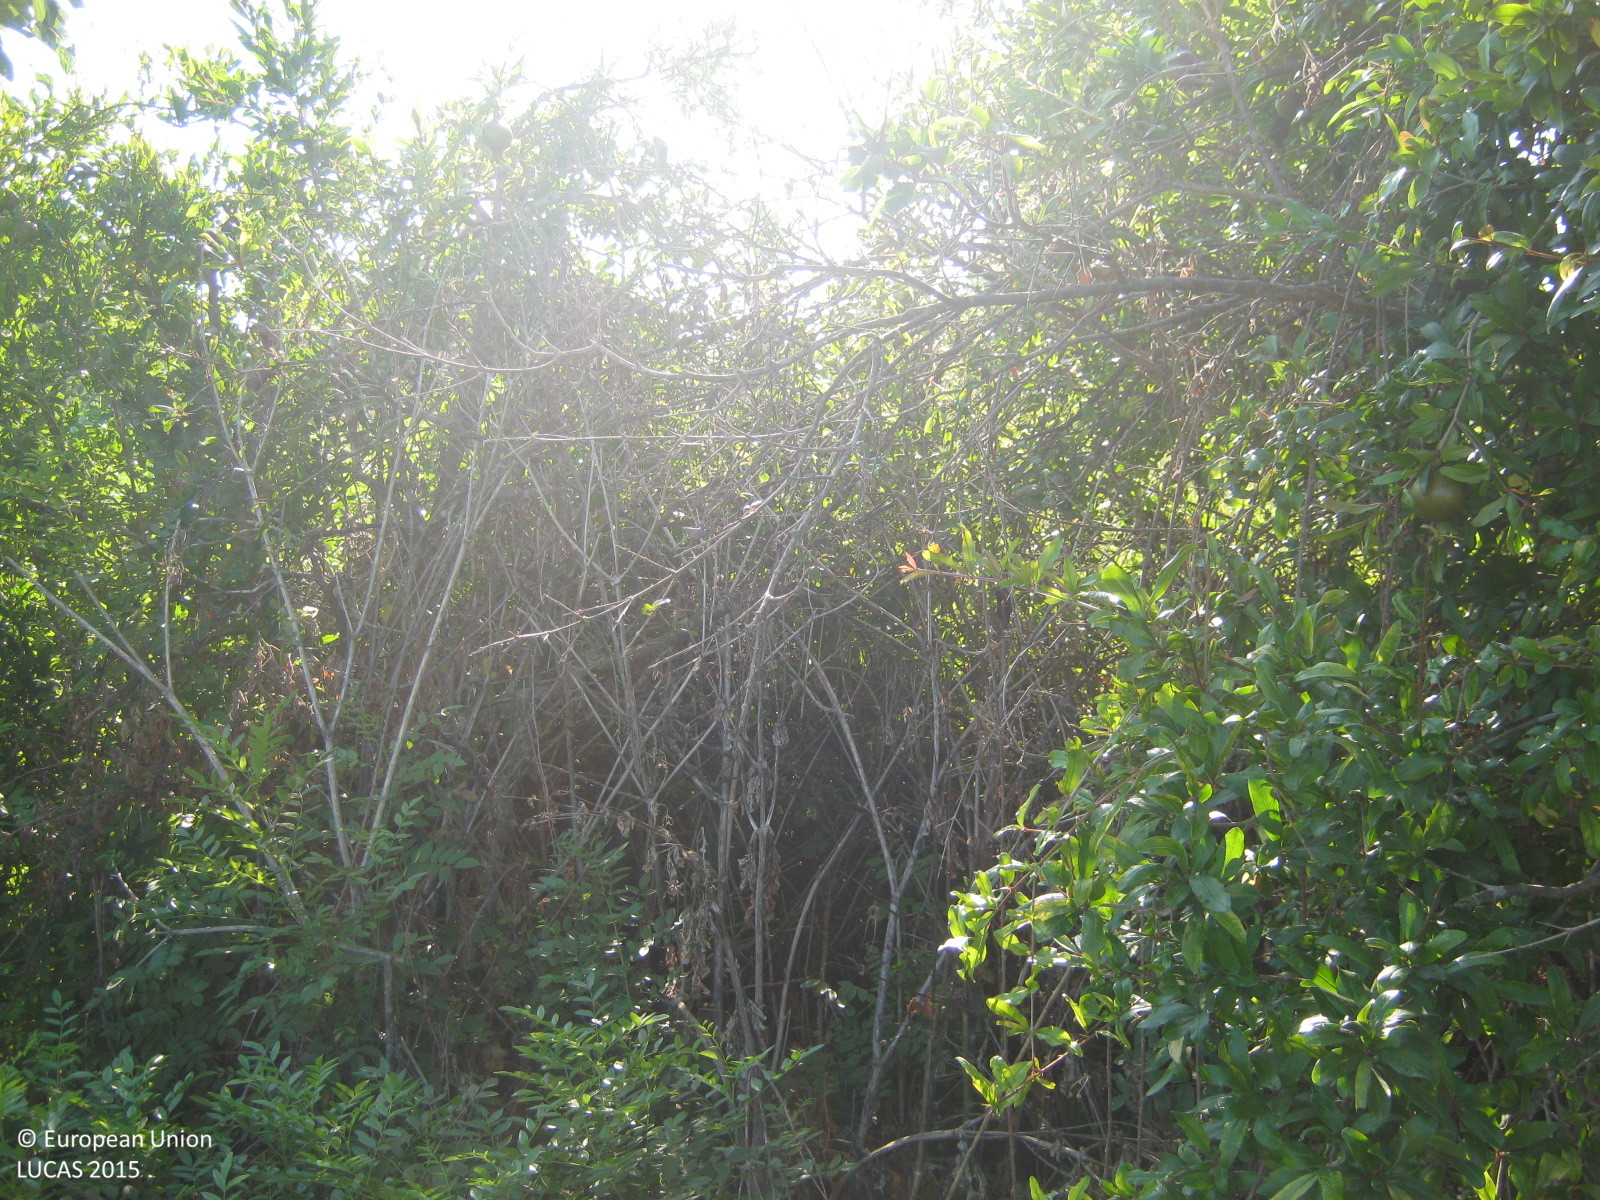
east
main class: Cropland
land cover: Maize
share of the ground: > 75 %
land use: Agriculture (excluding fallow land and kitchen gardens)
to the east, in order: Maize; Abandoned hedges; Spontaneously vegetated surfaces; Tracks; Olive groves; Artificial constructions in urban areas
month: July
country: GR
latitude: 37.9363
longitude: 21.2595
